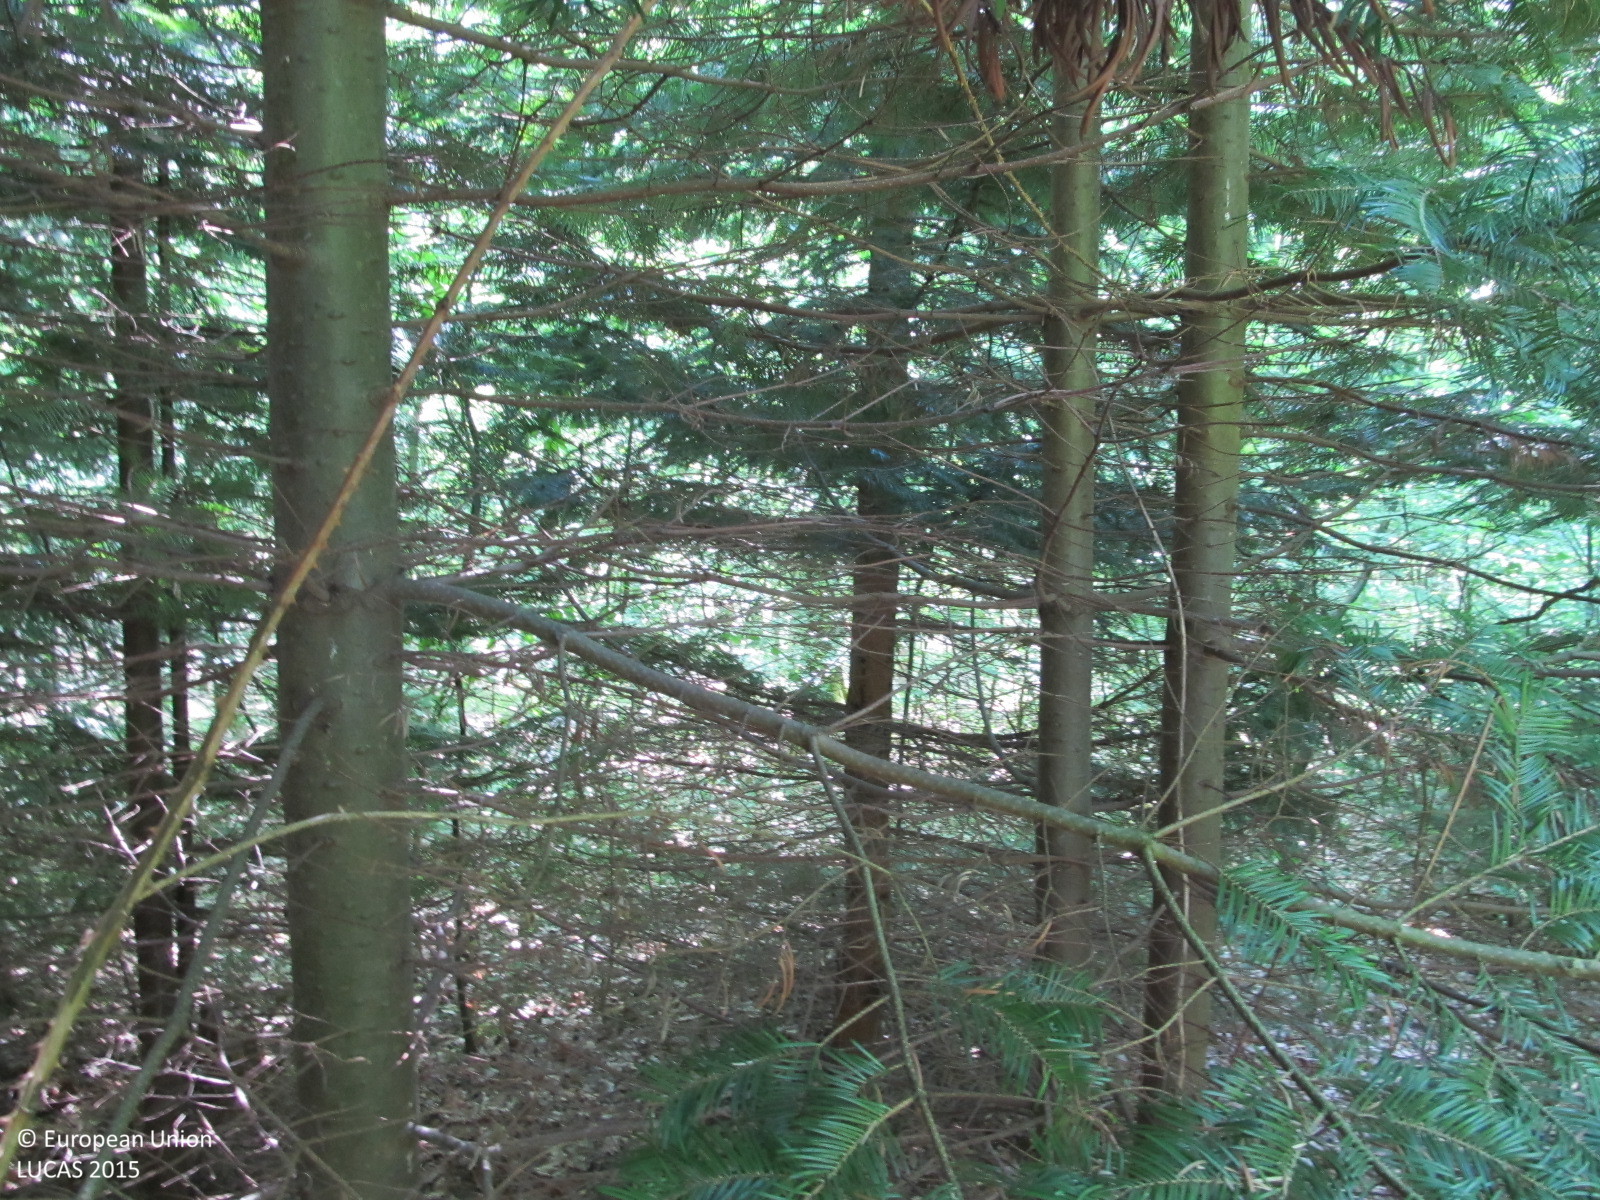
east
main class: Woodland
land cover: Other mixed woodland
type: hemiboreal forest and nemoral coniferous forest and mixed broadleaved-coniferous forest
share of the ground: > 75 %
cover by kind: coniferous forest trees 50 %, broadleaved forest trees 30 %, shrubs 10 %, herbaceous plants 10 %
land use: Forestry
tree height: > 5 m
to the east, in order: Other mixed woodland; Tracks; Other mixed woodland; Paved roads, cycling and walking lanes; Spruce dominated mixed woodland; Tracks; Grassland with sparse tree/shrub cover; Other mixed woodland
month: May
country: AT
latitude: 48.6910
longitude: 15.6684
